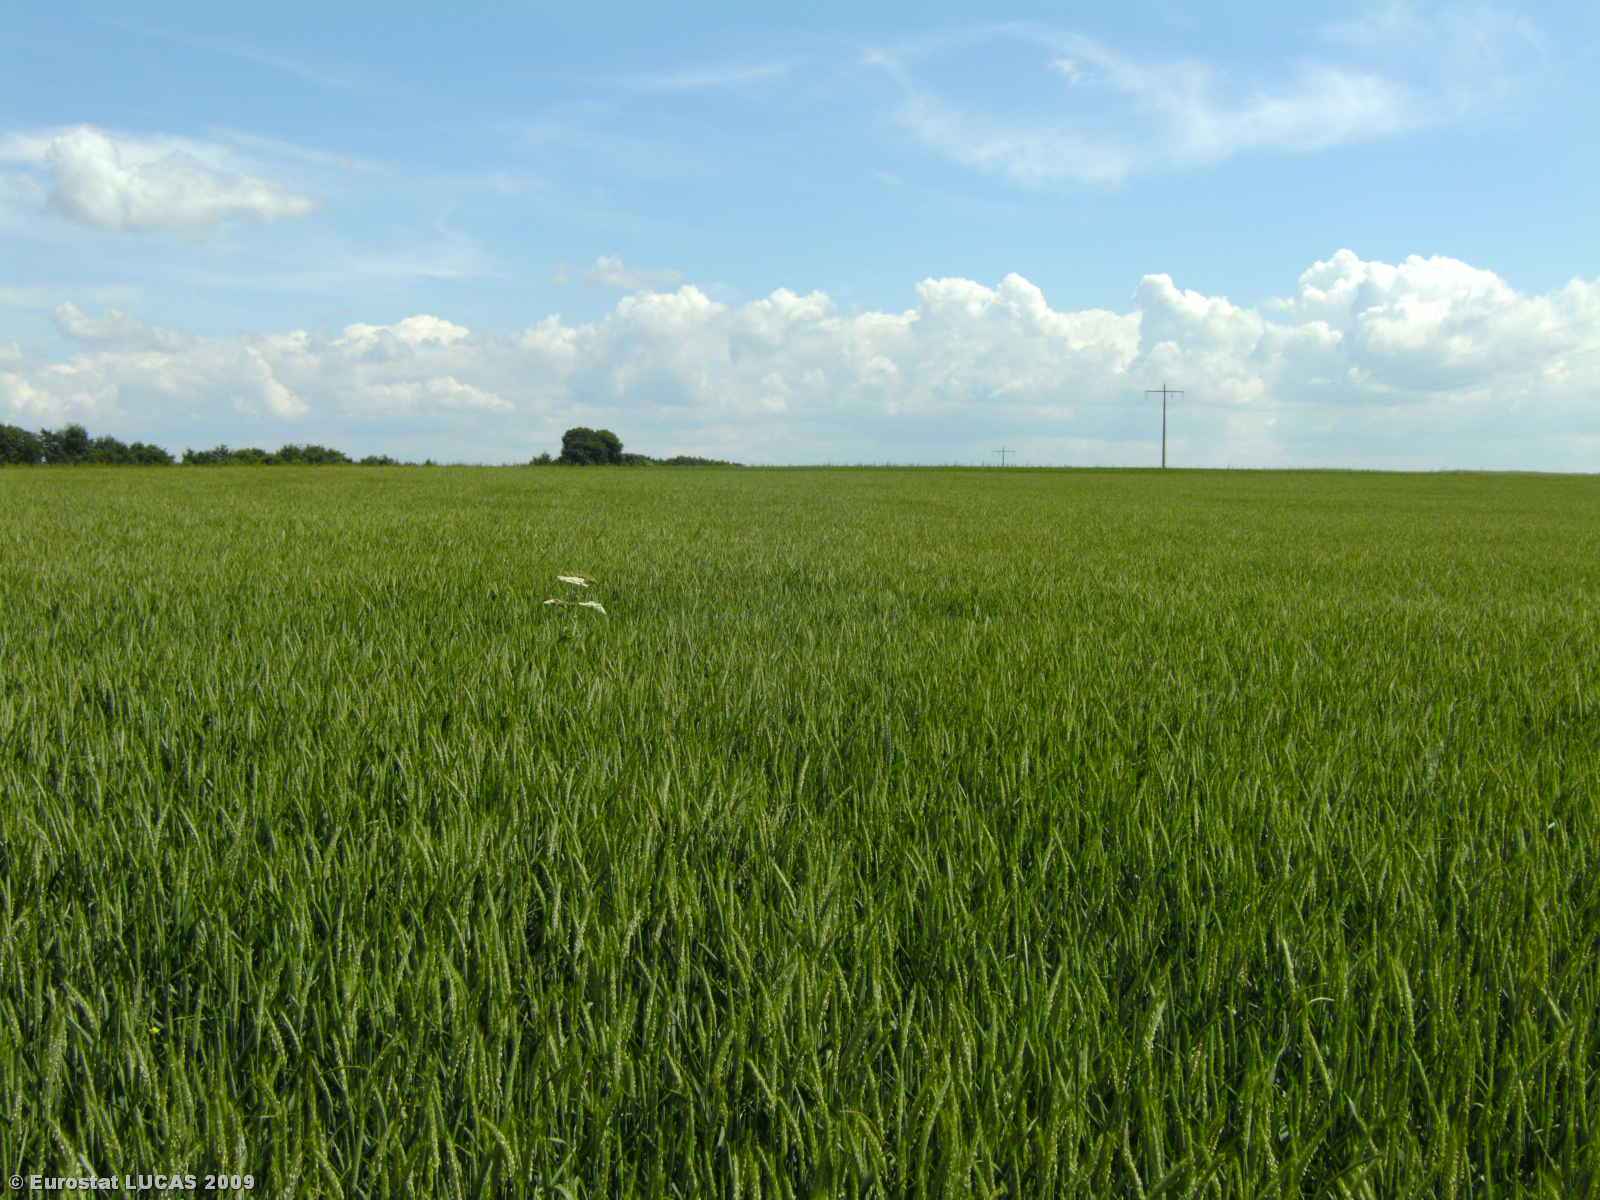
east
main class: Cropland
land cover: Rye
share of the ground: > 75 %
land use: Agriculture (excluding fallow land and kitchen gardens)
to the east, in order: Rye; Common wheat; Grass margins; Paved roads, cycling and walking lanes; Grass margins; Rape and turnip rape
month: June
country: LU
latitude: 49.5296
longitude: 6.2830
